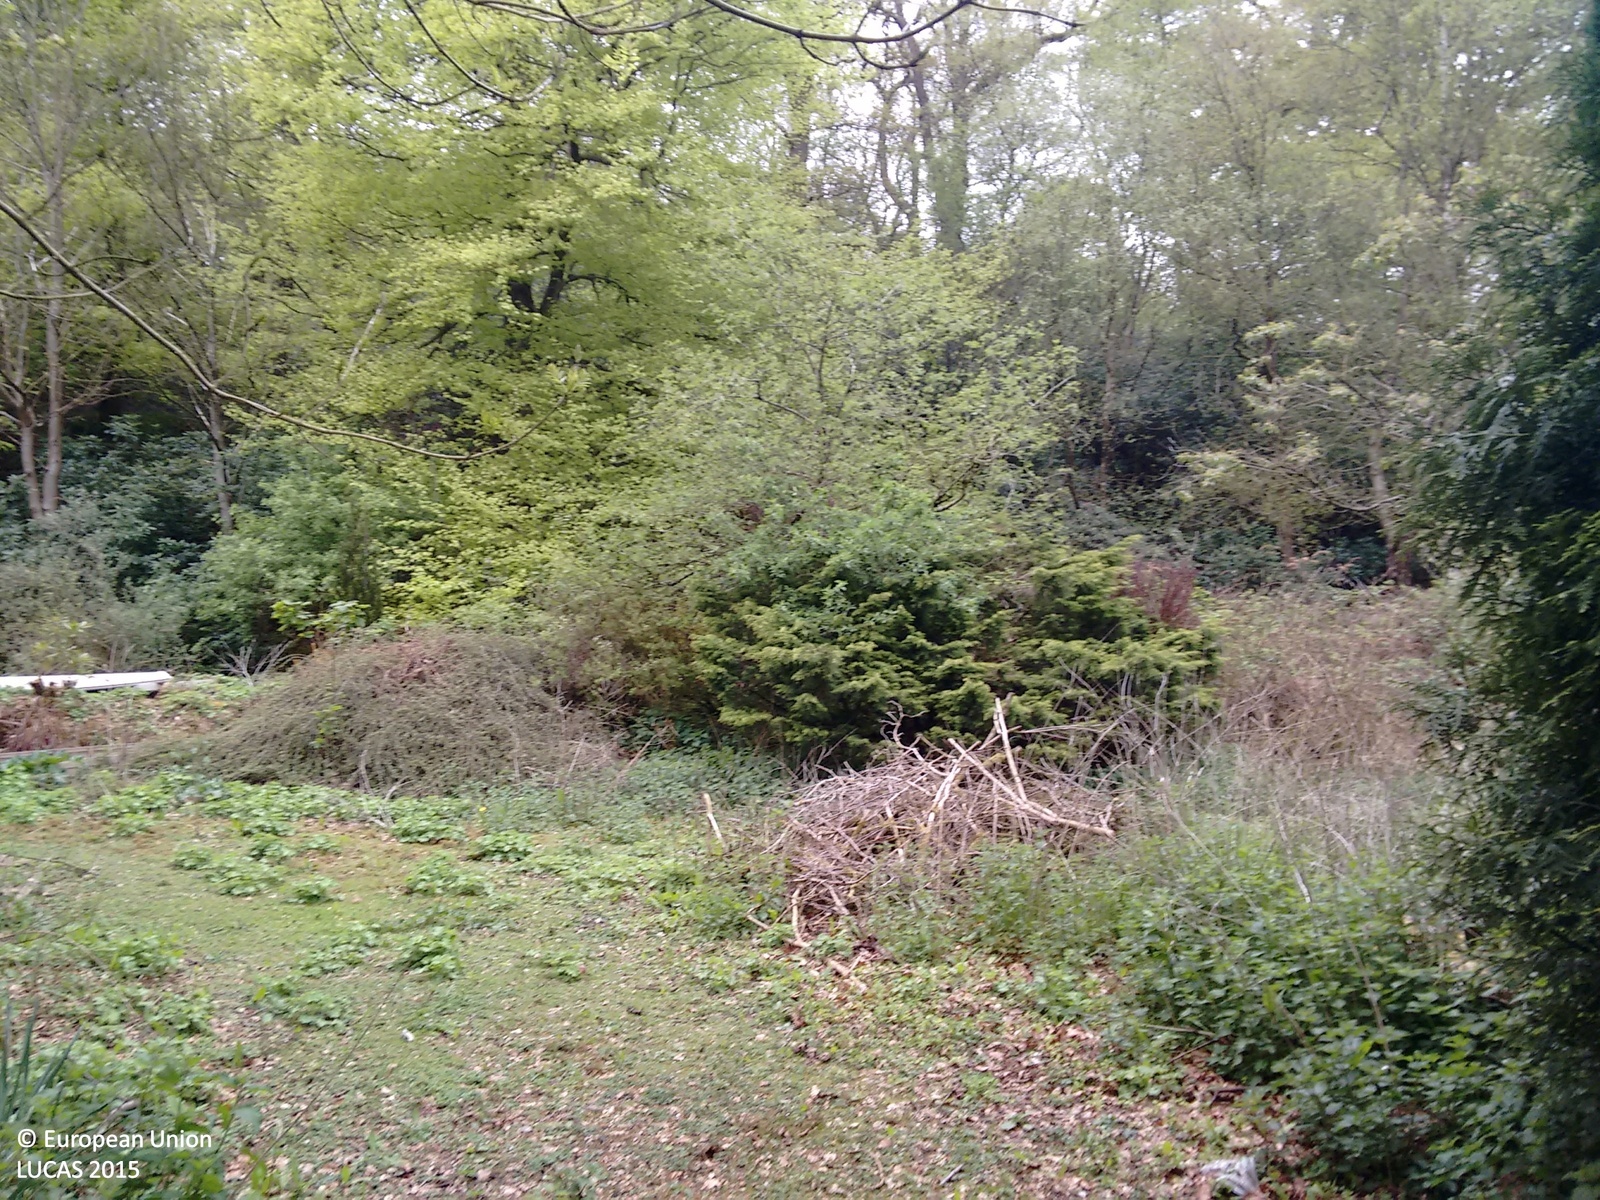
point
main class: Woodland
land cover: Other mixed woodland
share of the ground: > 75 %
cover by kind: coniferous forest trees 50 %, broadleaved forest trees 50 %
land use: Forestry
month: May
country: GB
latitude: 54.0736
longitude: -2.7380
